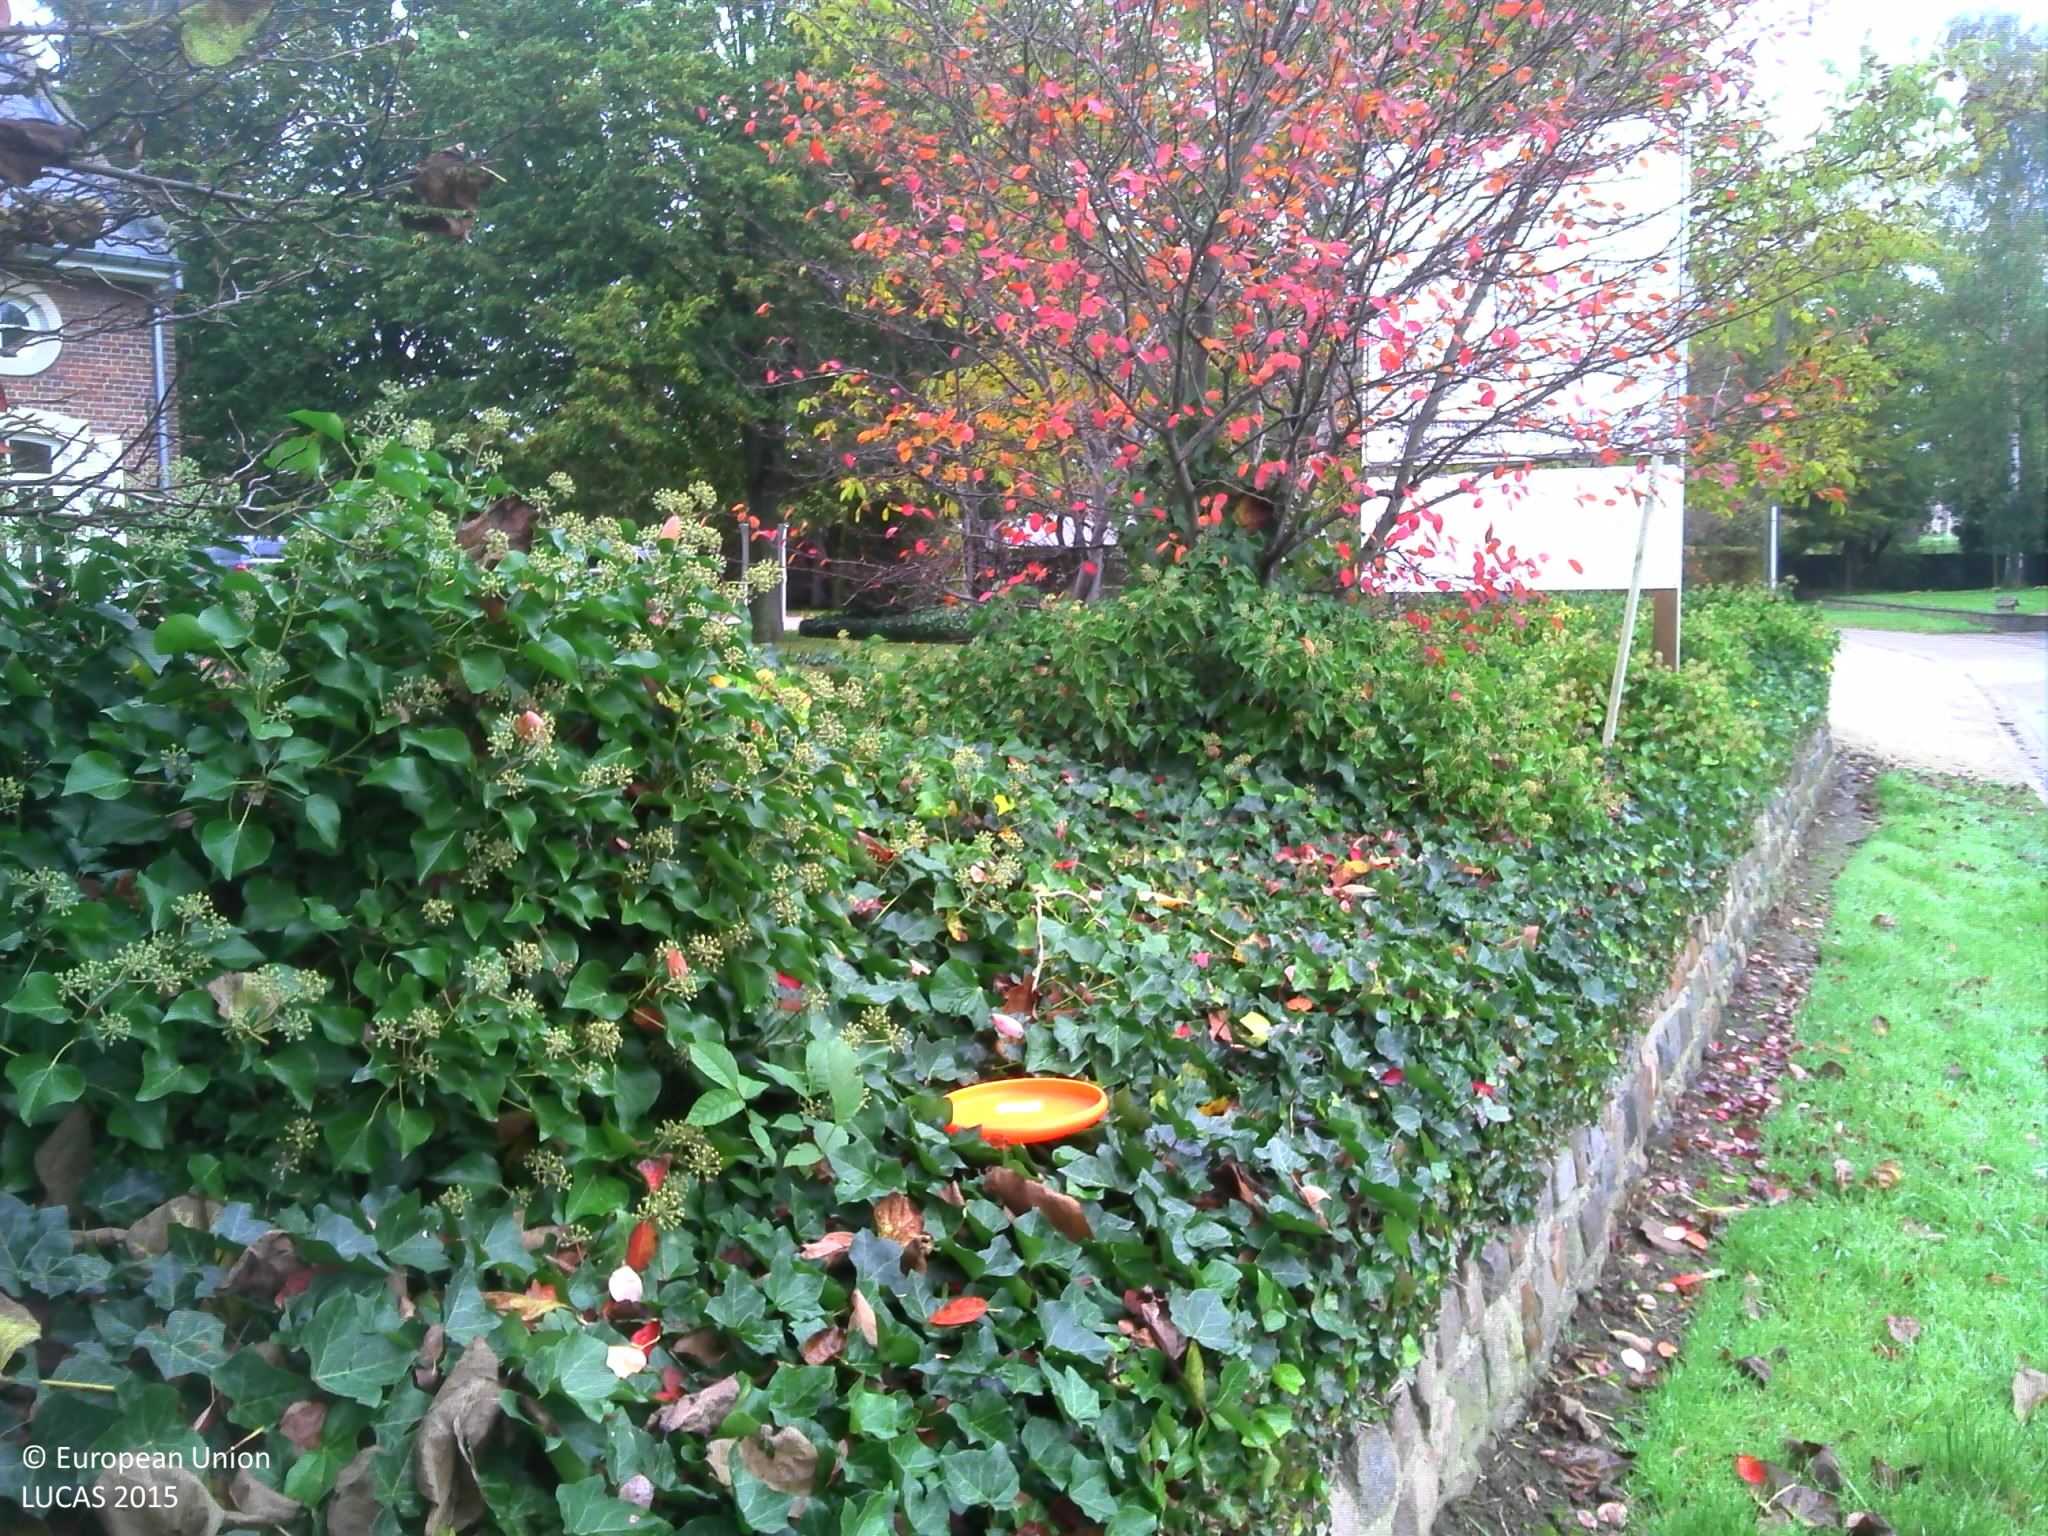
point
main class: Cropland
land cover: Floriculture and ornamental plants
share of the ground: > 75 %
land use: Residential
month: October
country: BE
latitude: 50.9127
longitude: 4.8052
